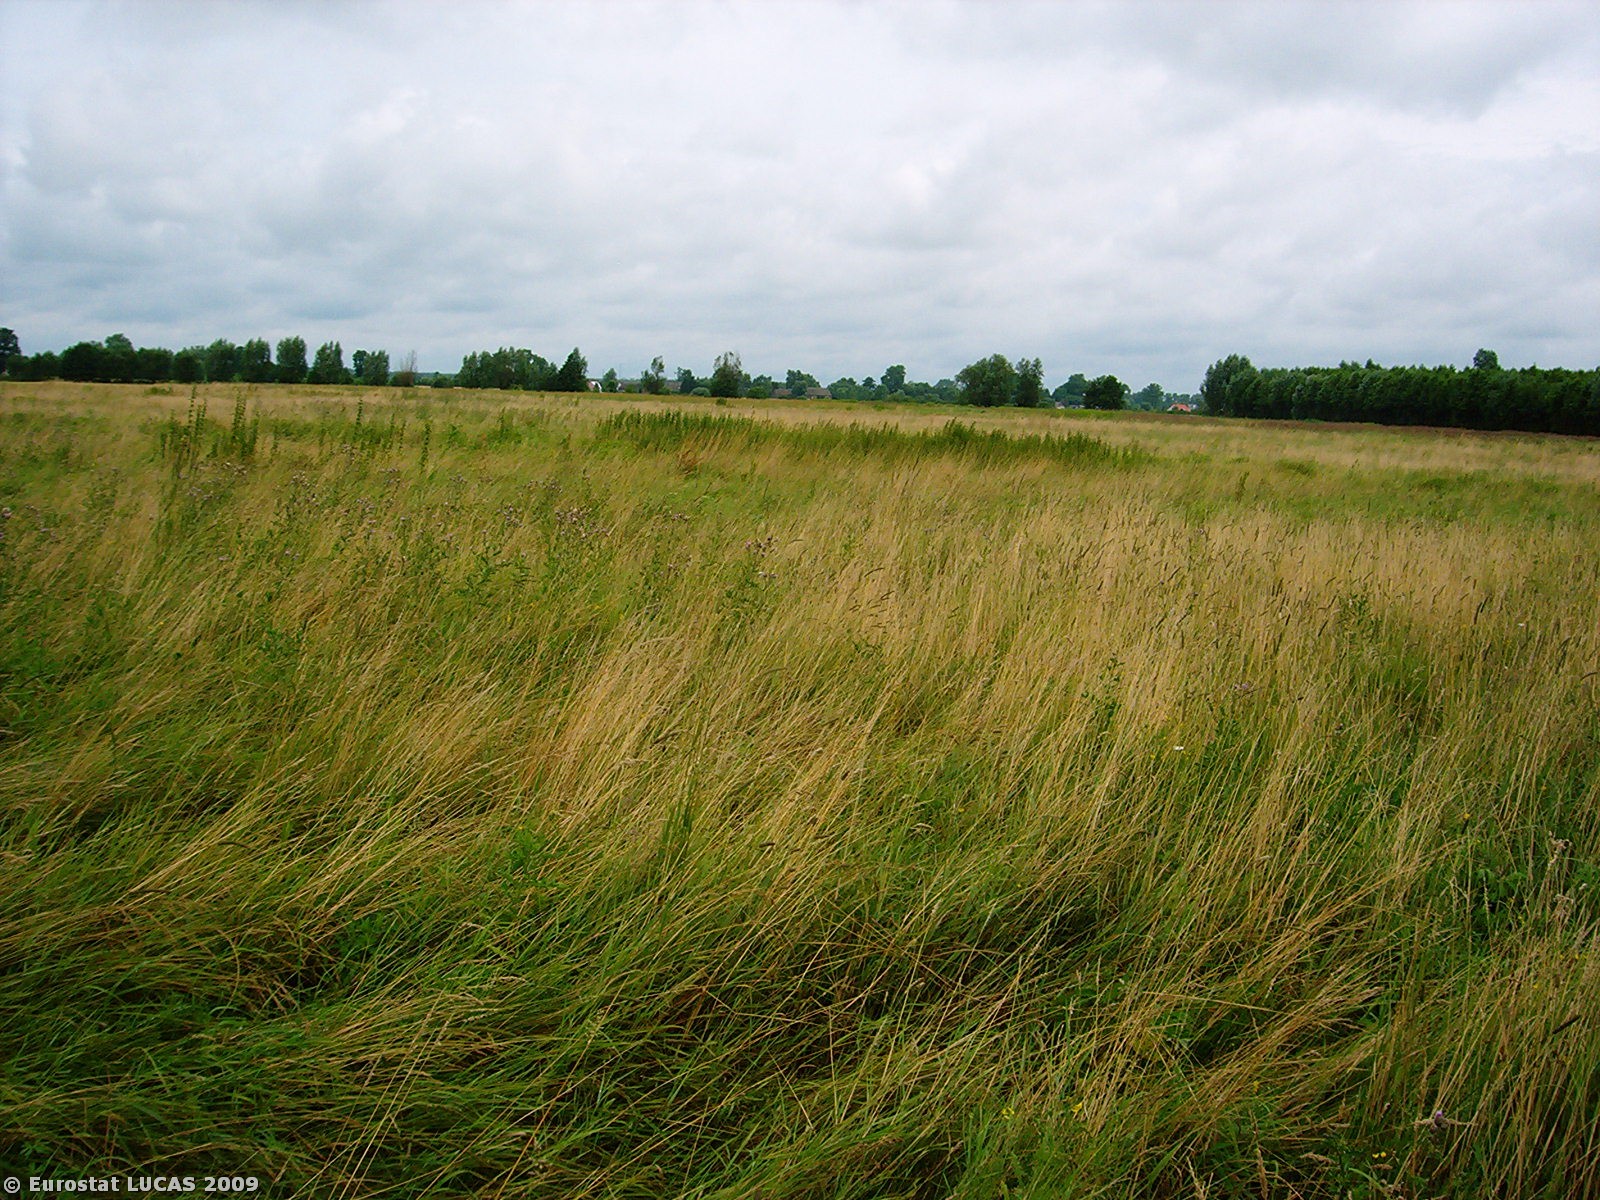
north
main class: Grassland
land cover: Grassland without tree/shrub cover
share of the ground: > 75 %
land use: Agriculture (excluding fallow land and kitchen gardens)
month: July
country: PL
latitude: 52.6410
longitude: 15.2198
